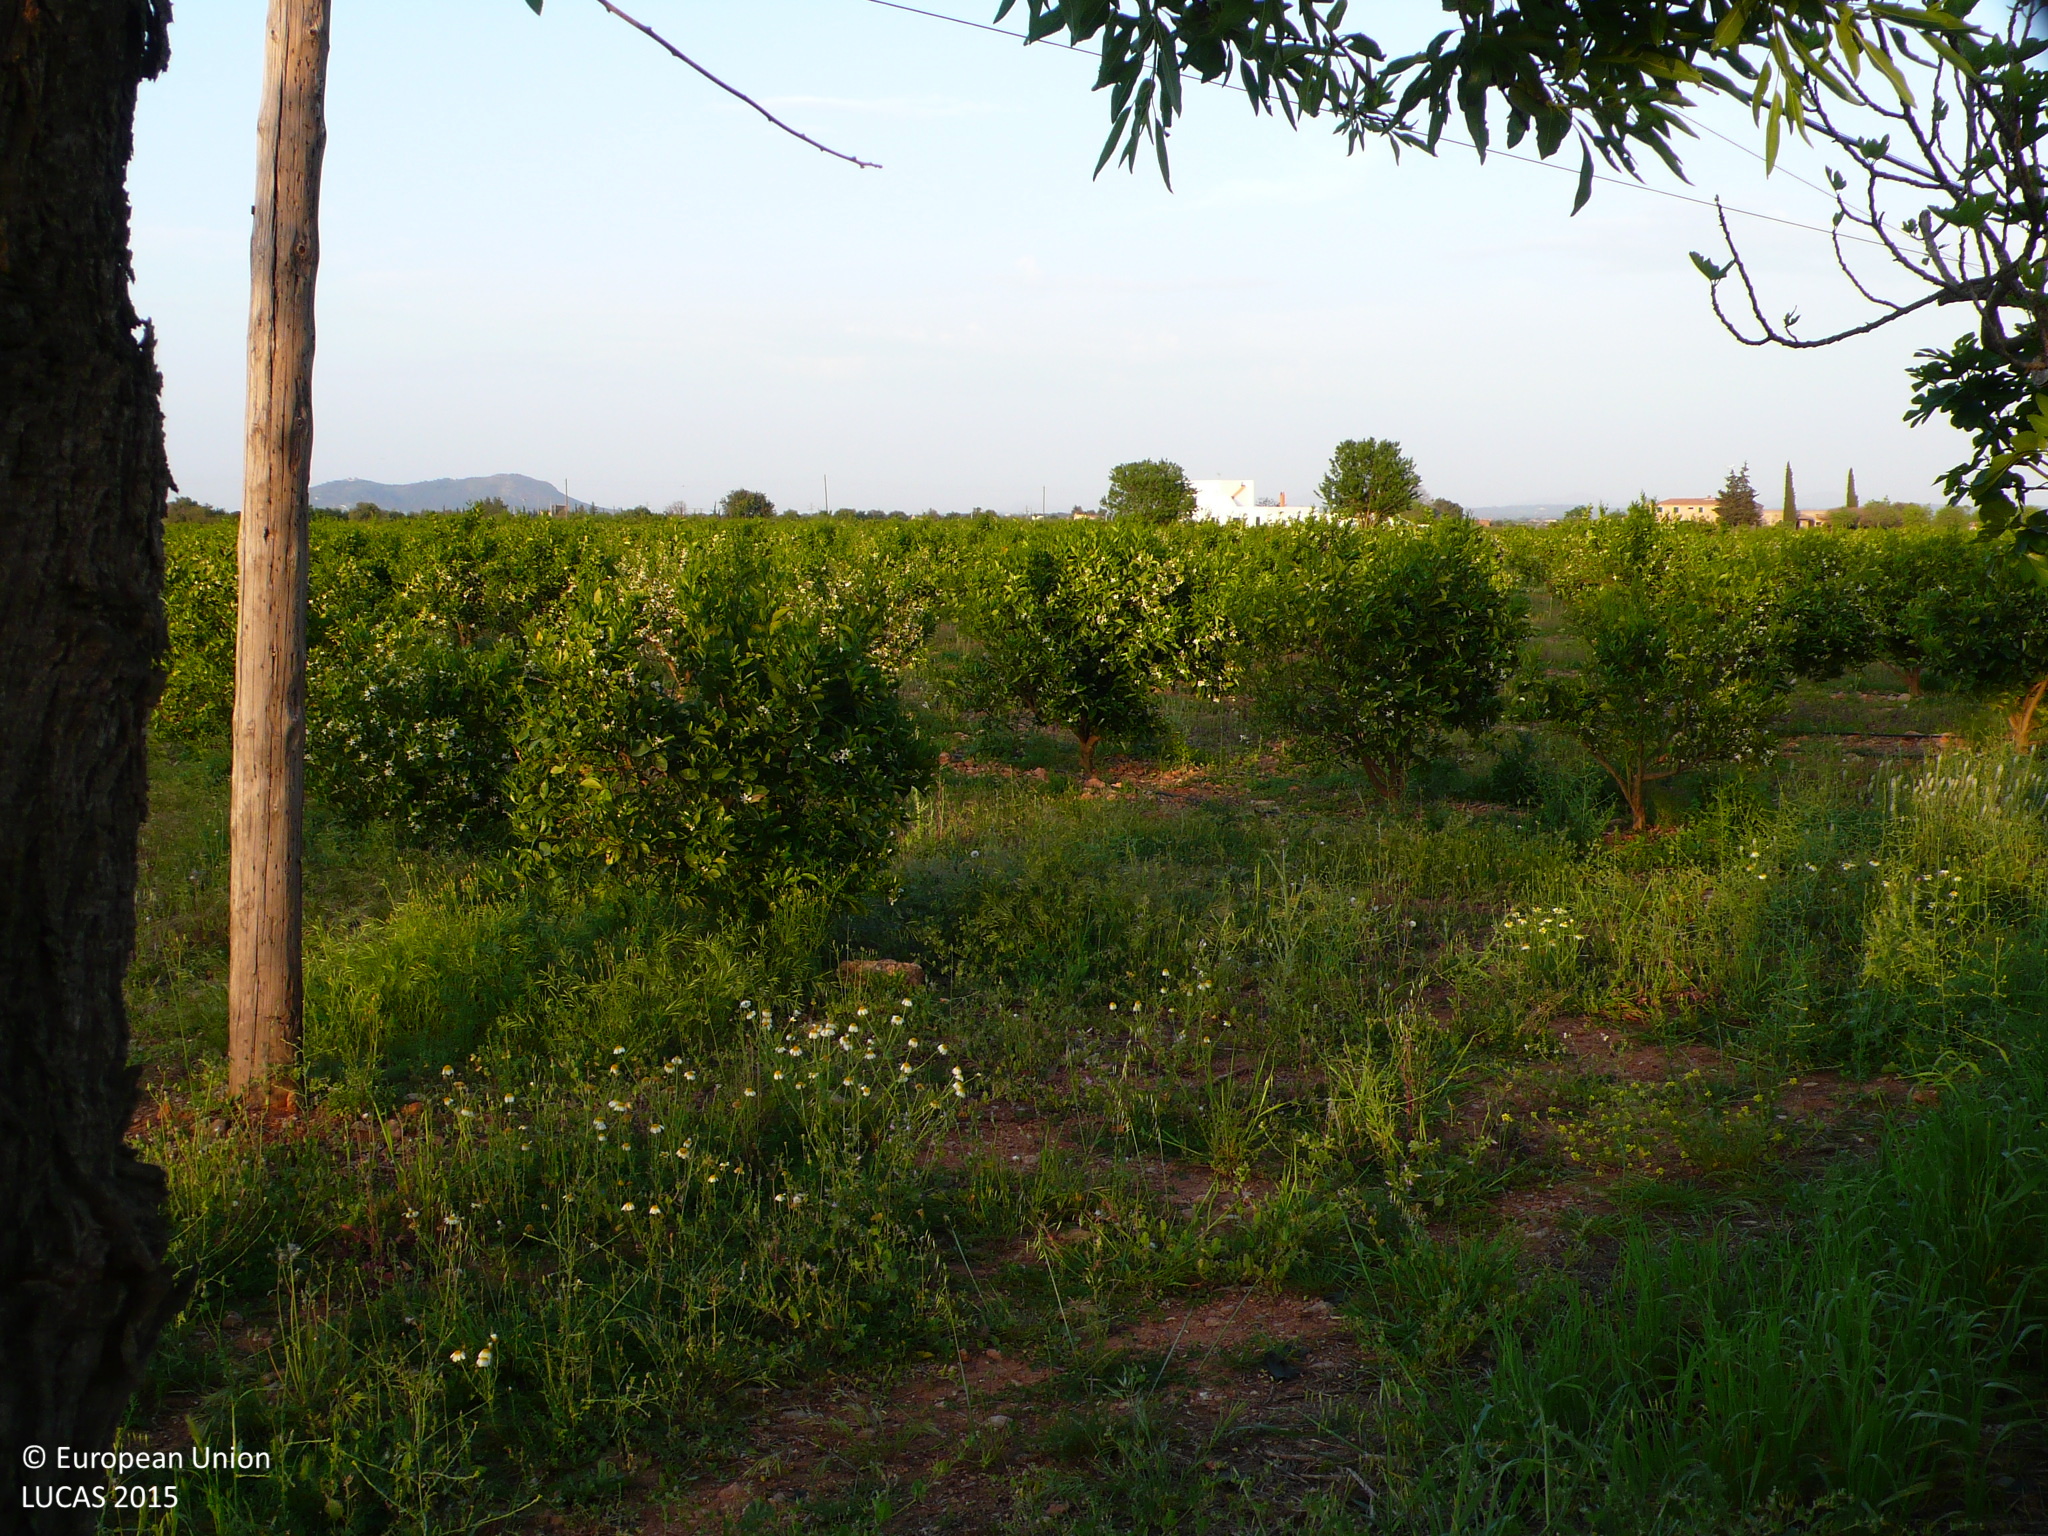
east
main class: Cropland
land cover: Oranges
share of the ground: 25 - 50 %
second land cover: Spontaneously vegetated surfaces
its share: > 75 %
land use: Agriculture (excluding fallow land and kitchen gardens)
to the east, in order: Oranges; Spontaneously vegetated surfaces; Tracks; Electric lines; Dry stone walls; Oranges; Permanent crops (only in case pi)
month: April
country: ES
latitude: 39.6799
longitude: 2.8593
